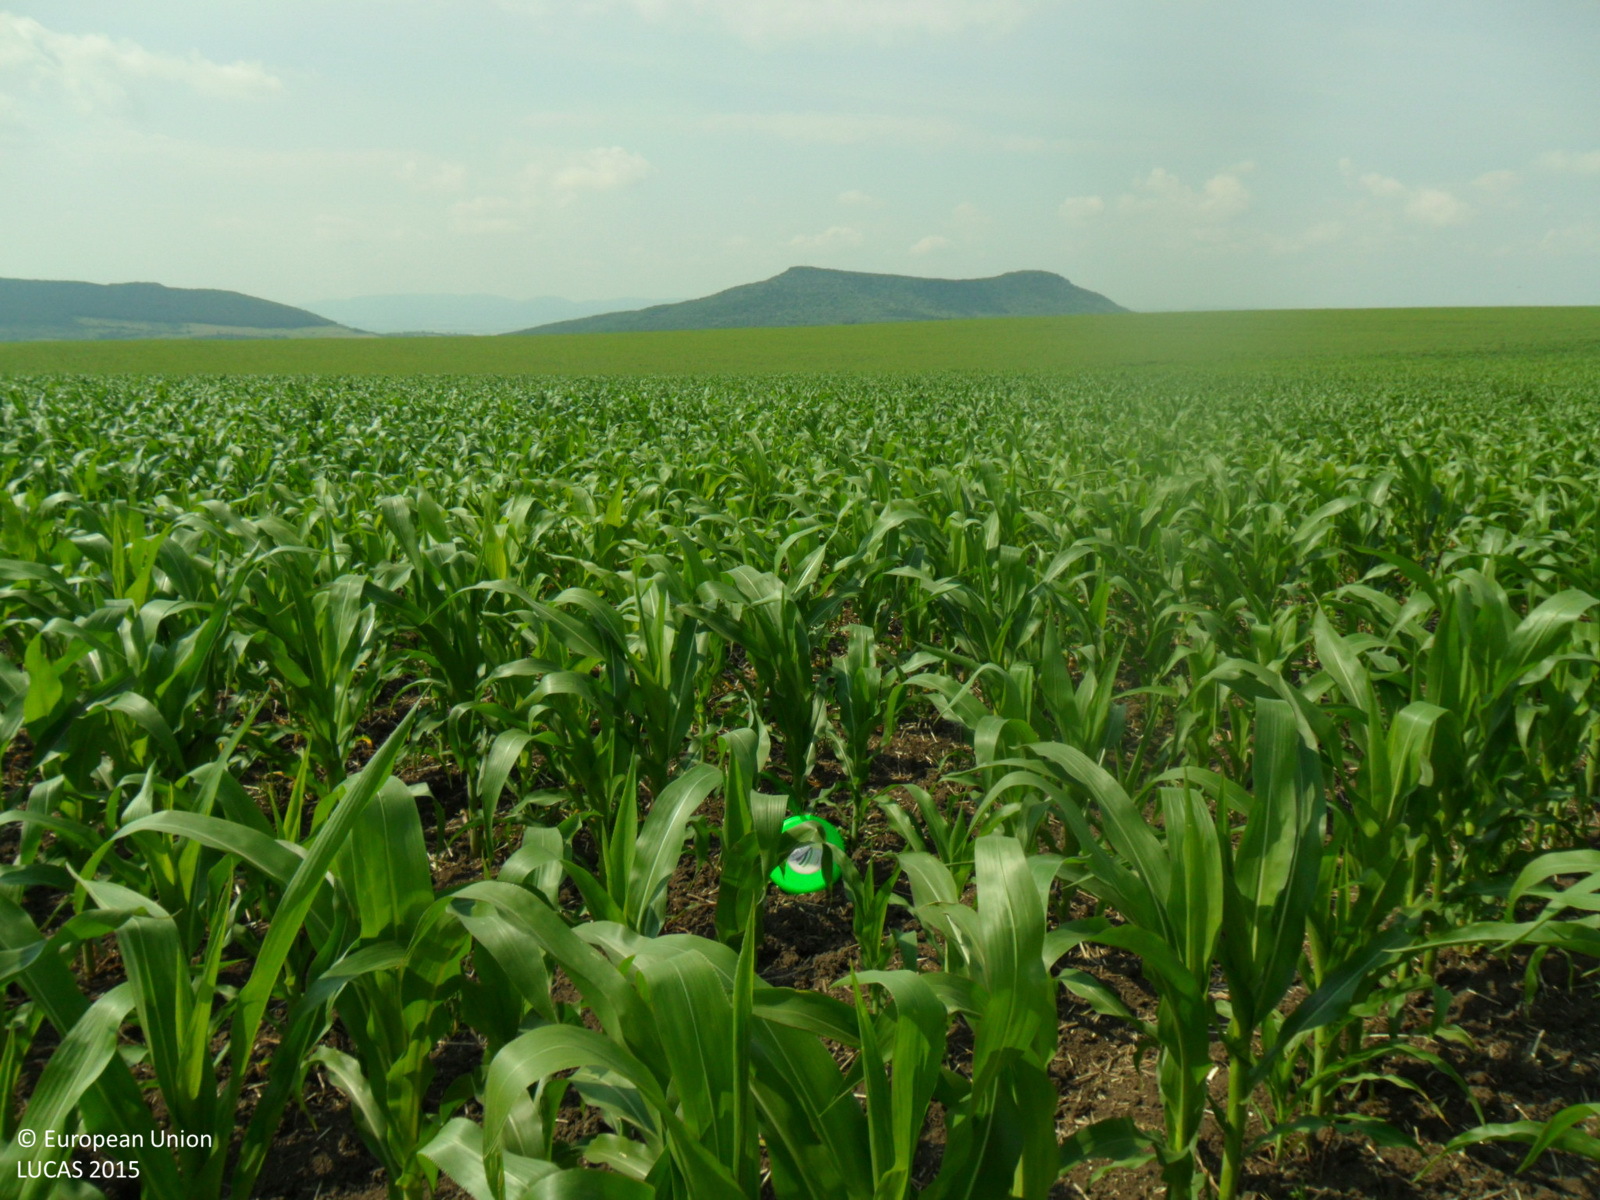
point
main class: Cropland
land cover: Maize
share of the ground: > 75 %
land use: Agriculture (excluding fallow land and kitchen gardens)
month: June
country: BG
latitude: 43.3586
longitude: 26.7796
